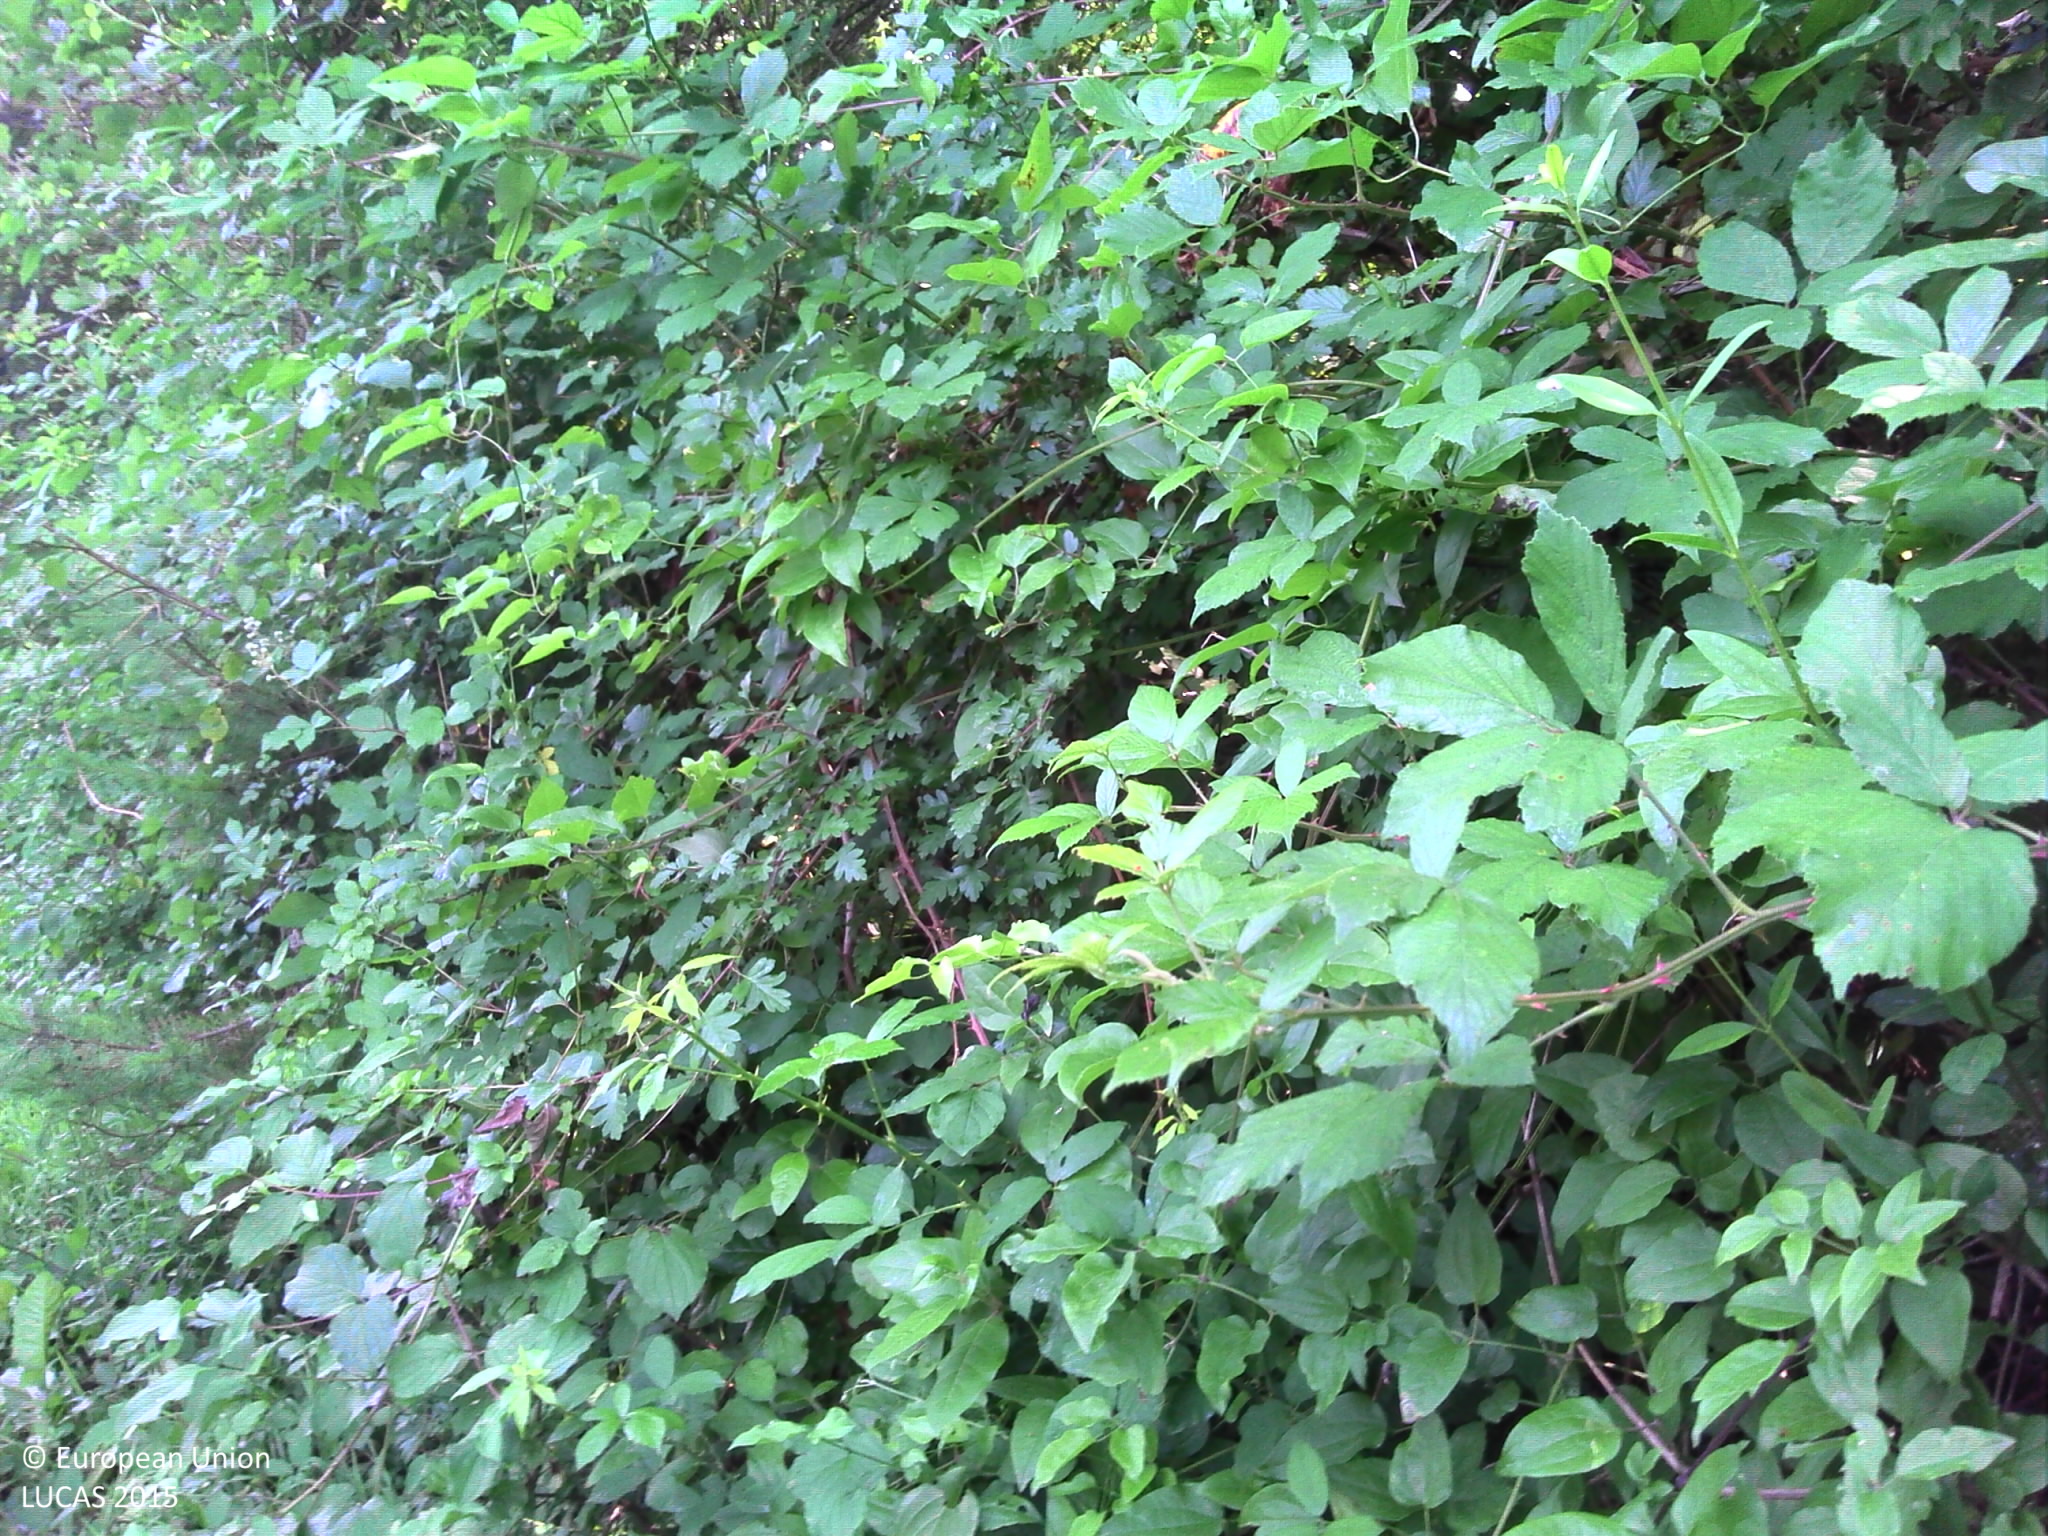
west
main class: Grassland
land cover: Grassland with sparse tree/shrub cover
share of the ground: > 75 %
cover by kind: herbaceous plants 90 %, broadleaved forest trees 5 %, shrubs 5 %
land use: Residential
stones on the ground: 25 - 50 %
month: June
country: FR
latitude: 44.7151
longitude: 4.9443
